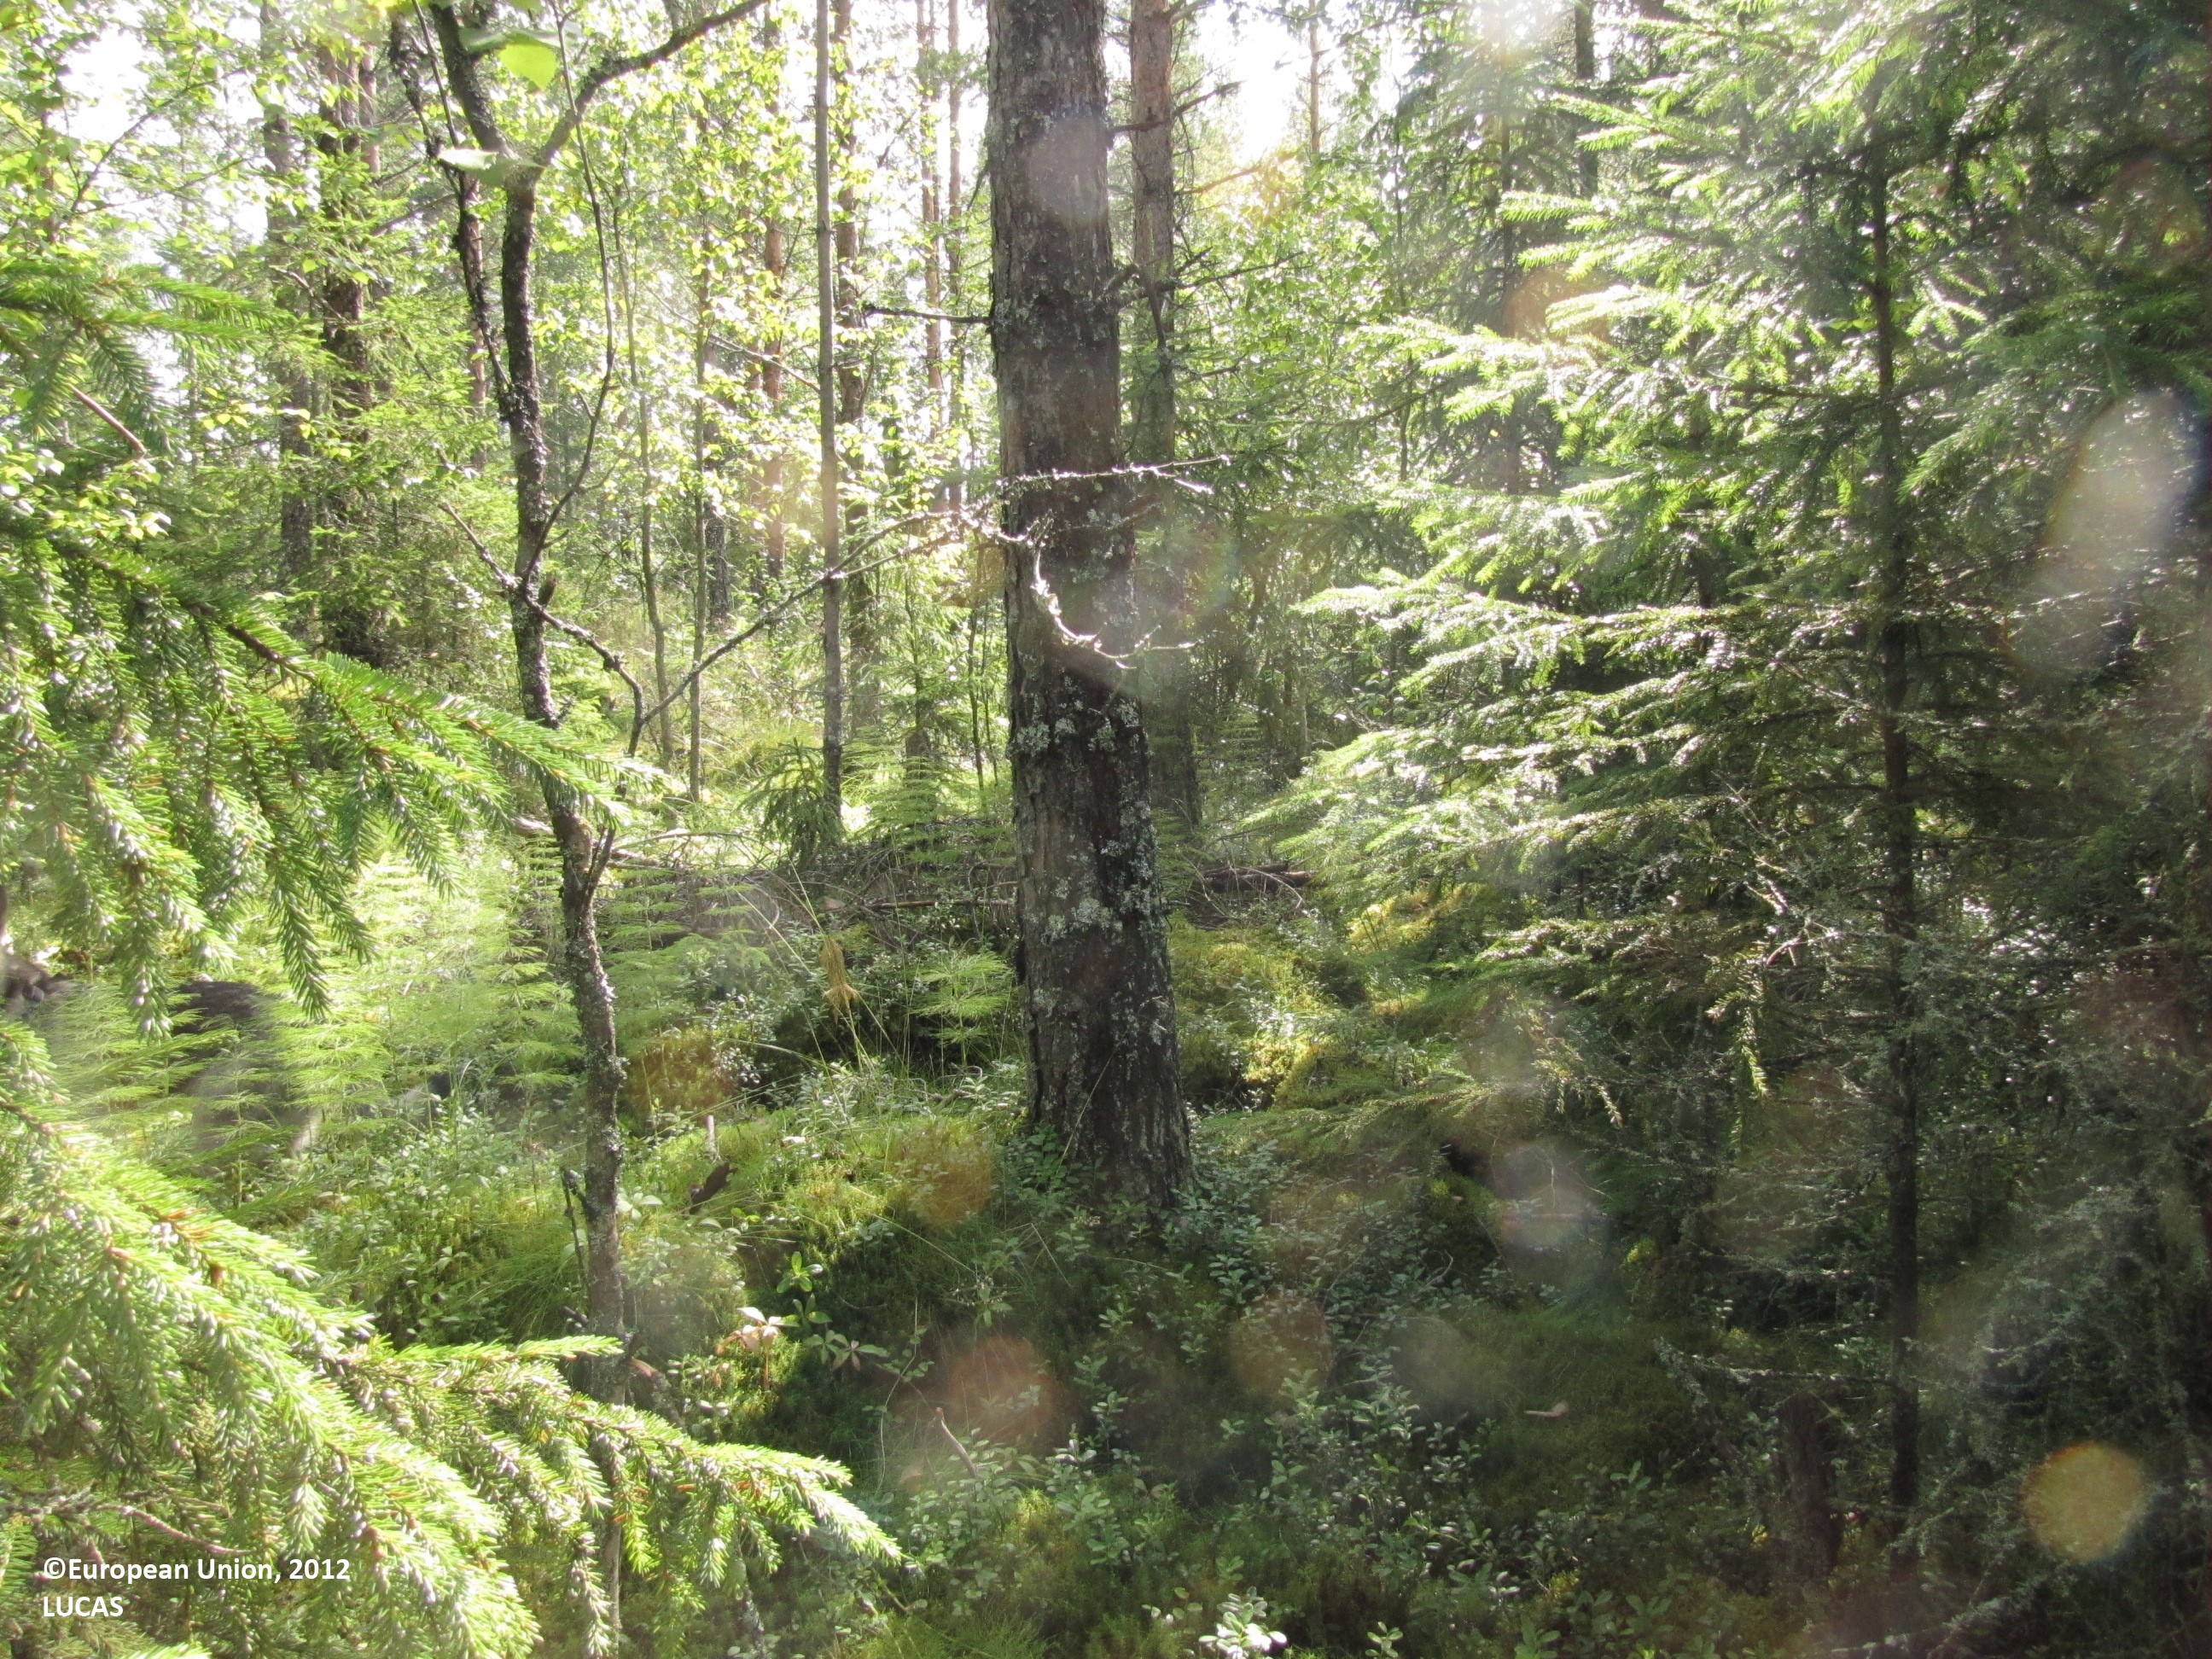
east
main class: Woodland
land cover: Other coniferous woodland
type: boreal forest
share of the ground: 50 - 75 %
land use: Forestry
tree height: > 5 m
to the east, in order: Other coniferous woodland; Pine dominated mixed woodland; Grassland with sparse tree/shrub cover; Pine dominated coniferous woodland
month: July
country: FI
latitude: 62.2389
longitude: 23.0953
